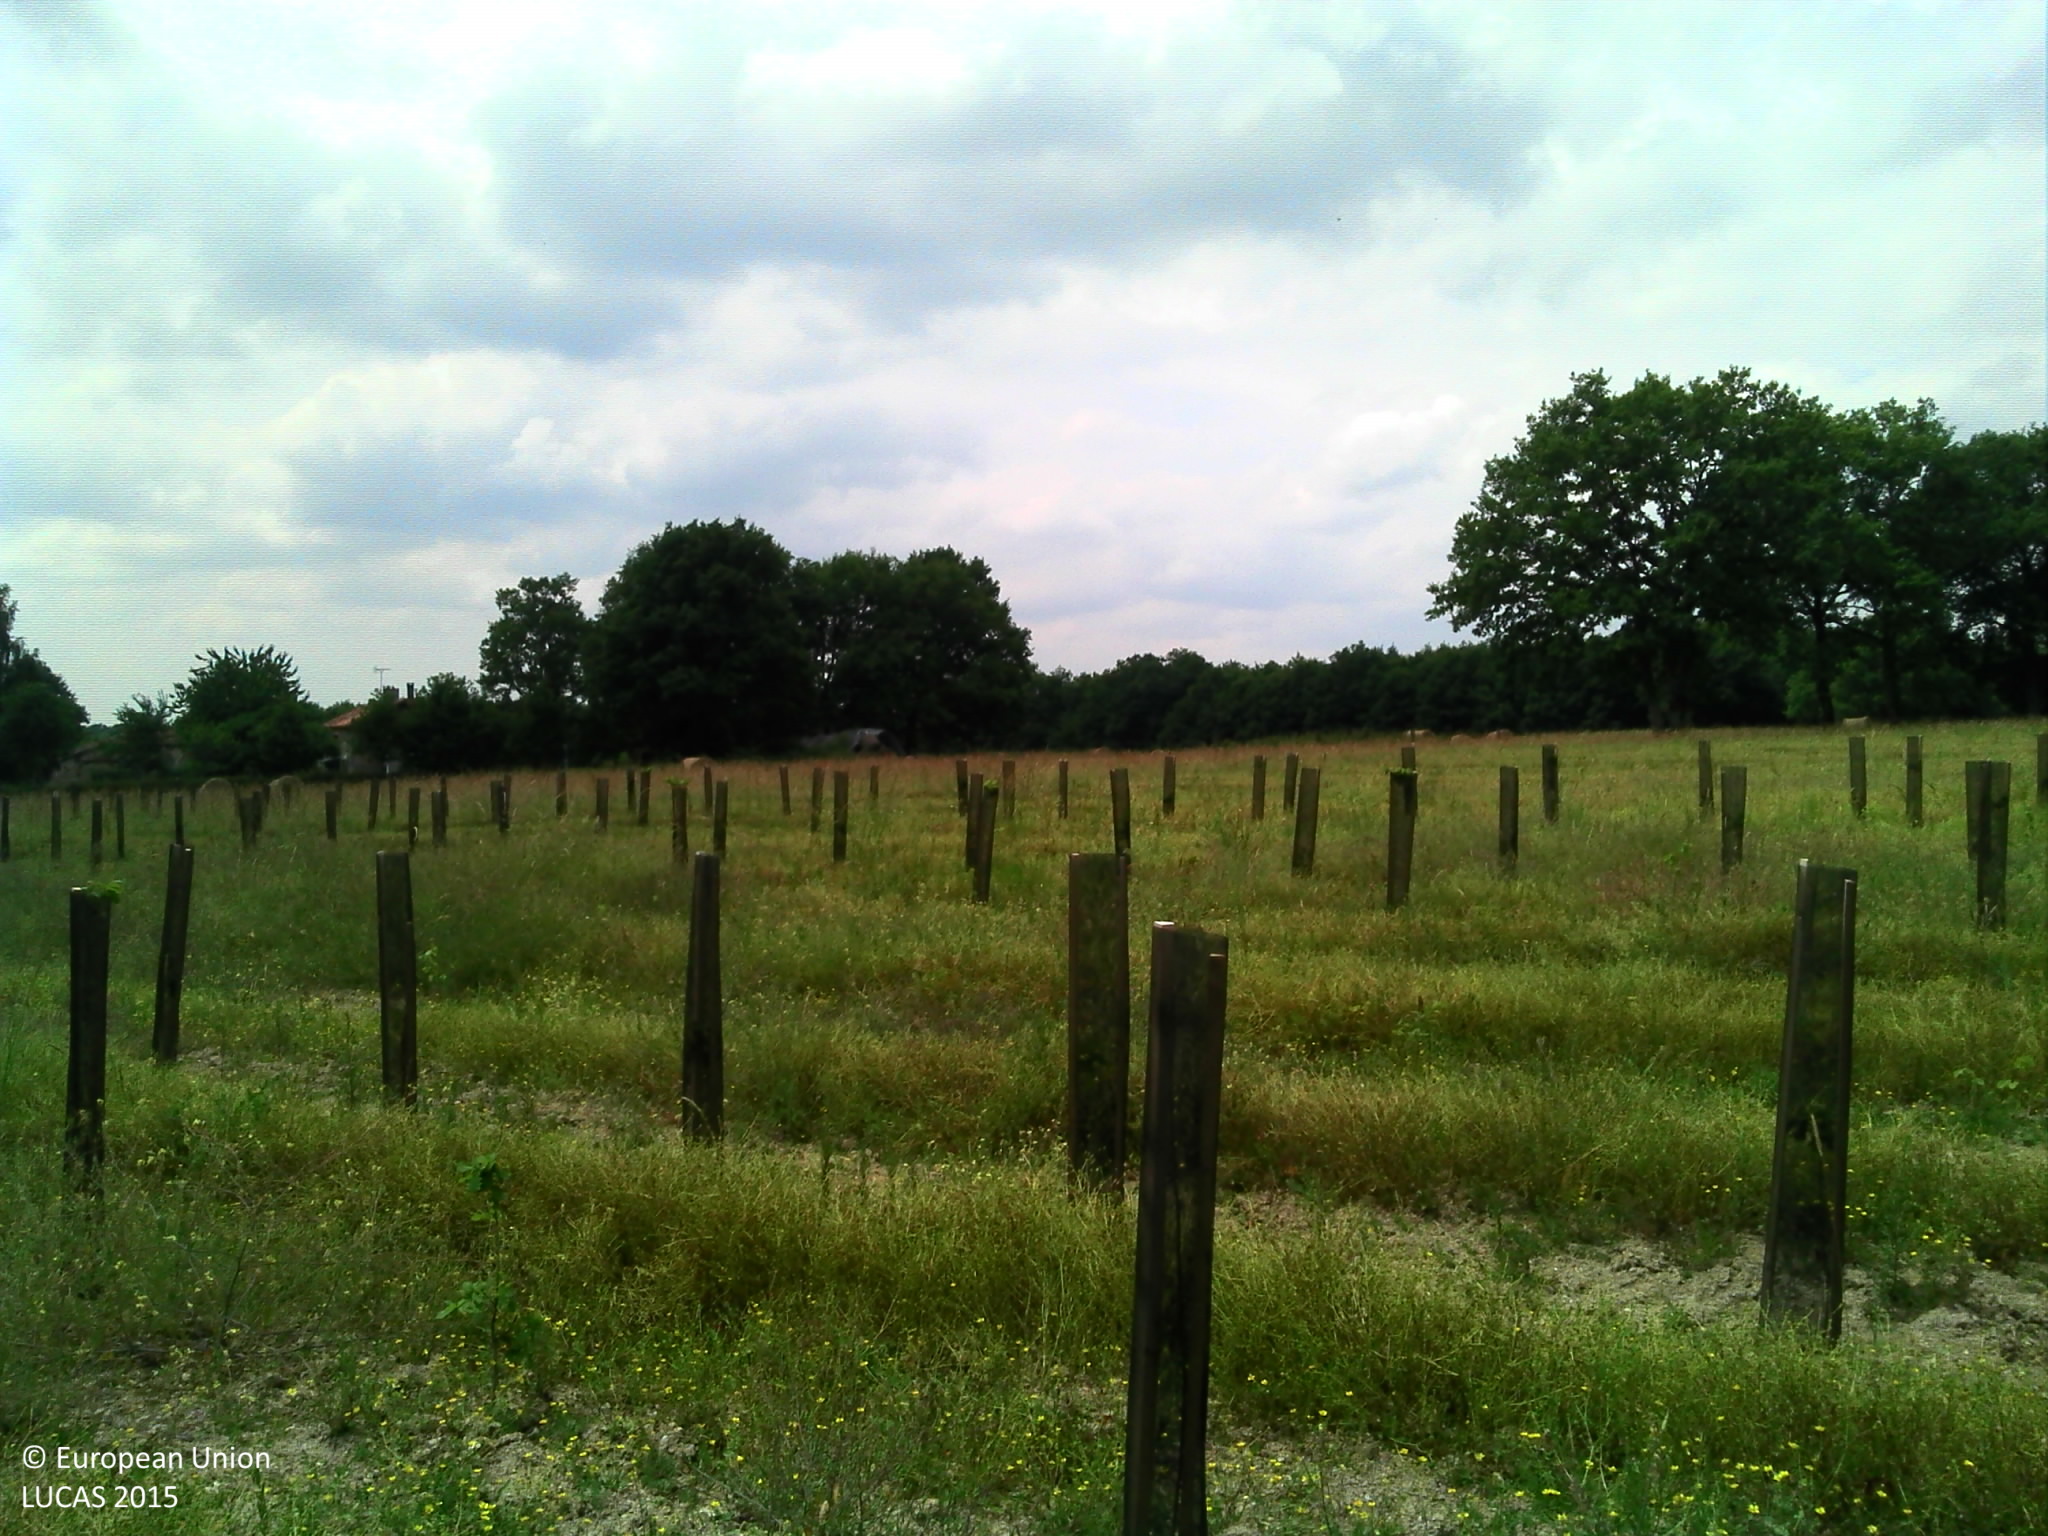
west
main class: Cropland
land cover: Nurseries
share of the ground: 10 - 25 %
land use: Forestry
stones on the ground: 10 - 25 %
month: June
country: FR
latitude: 45.9885
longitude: 0.5741
